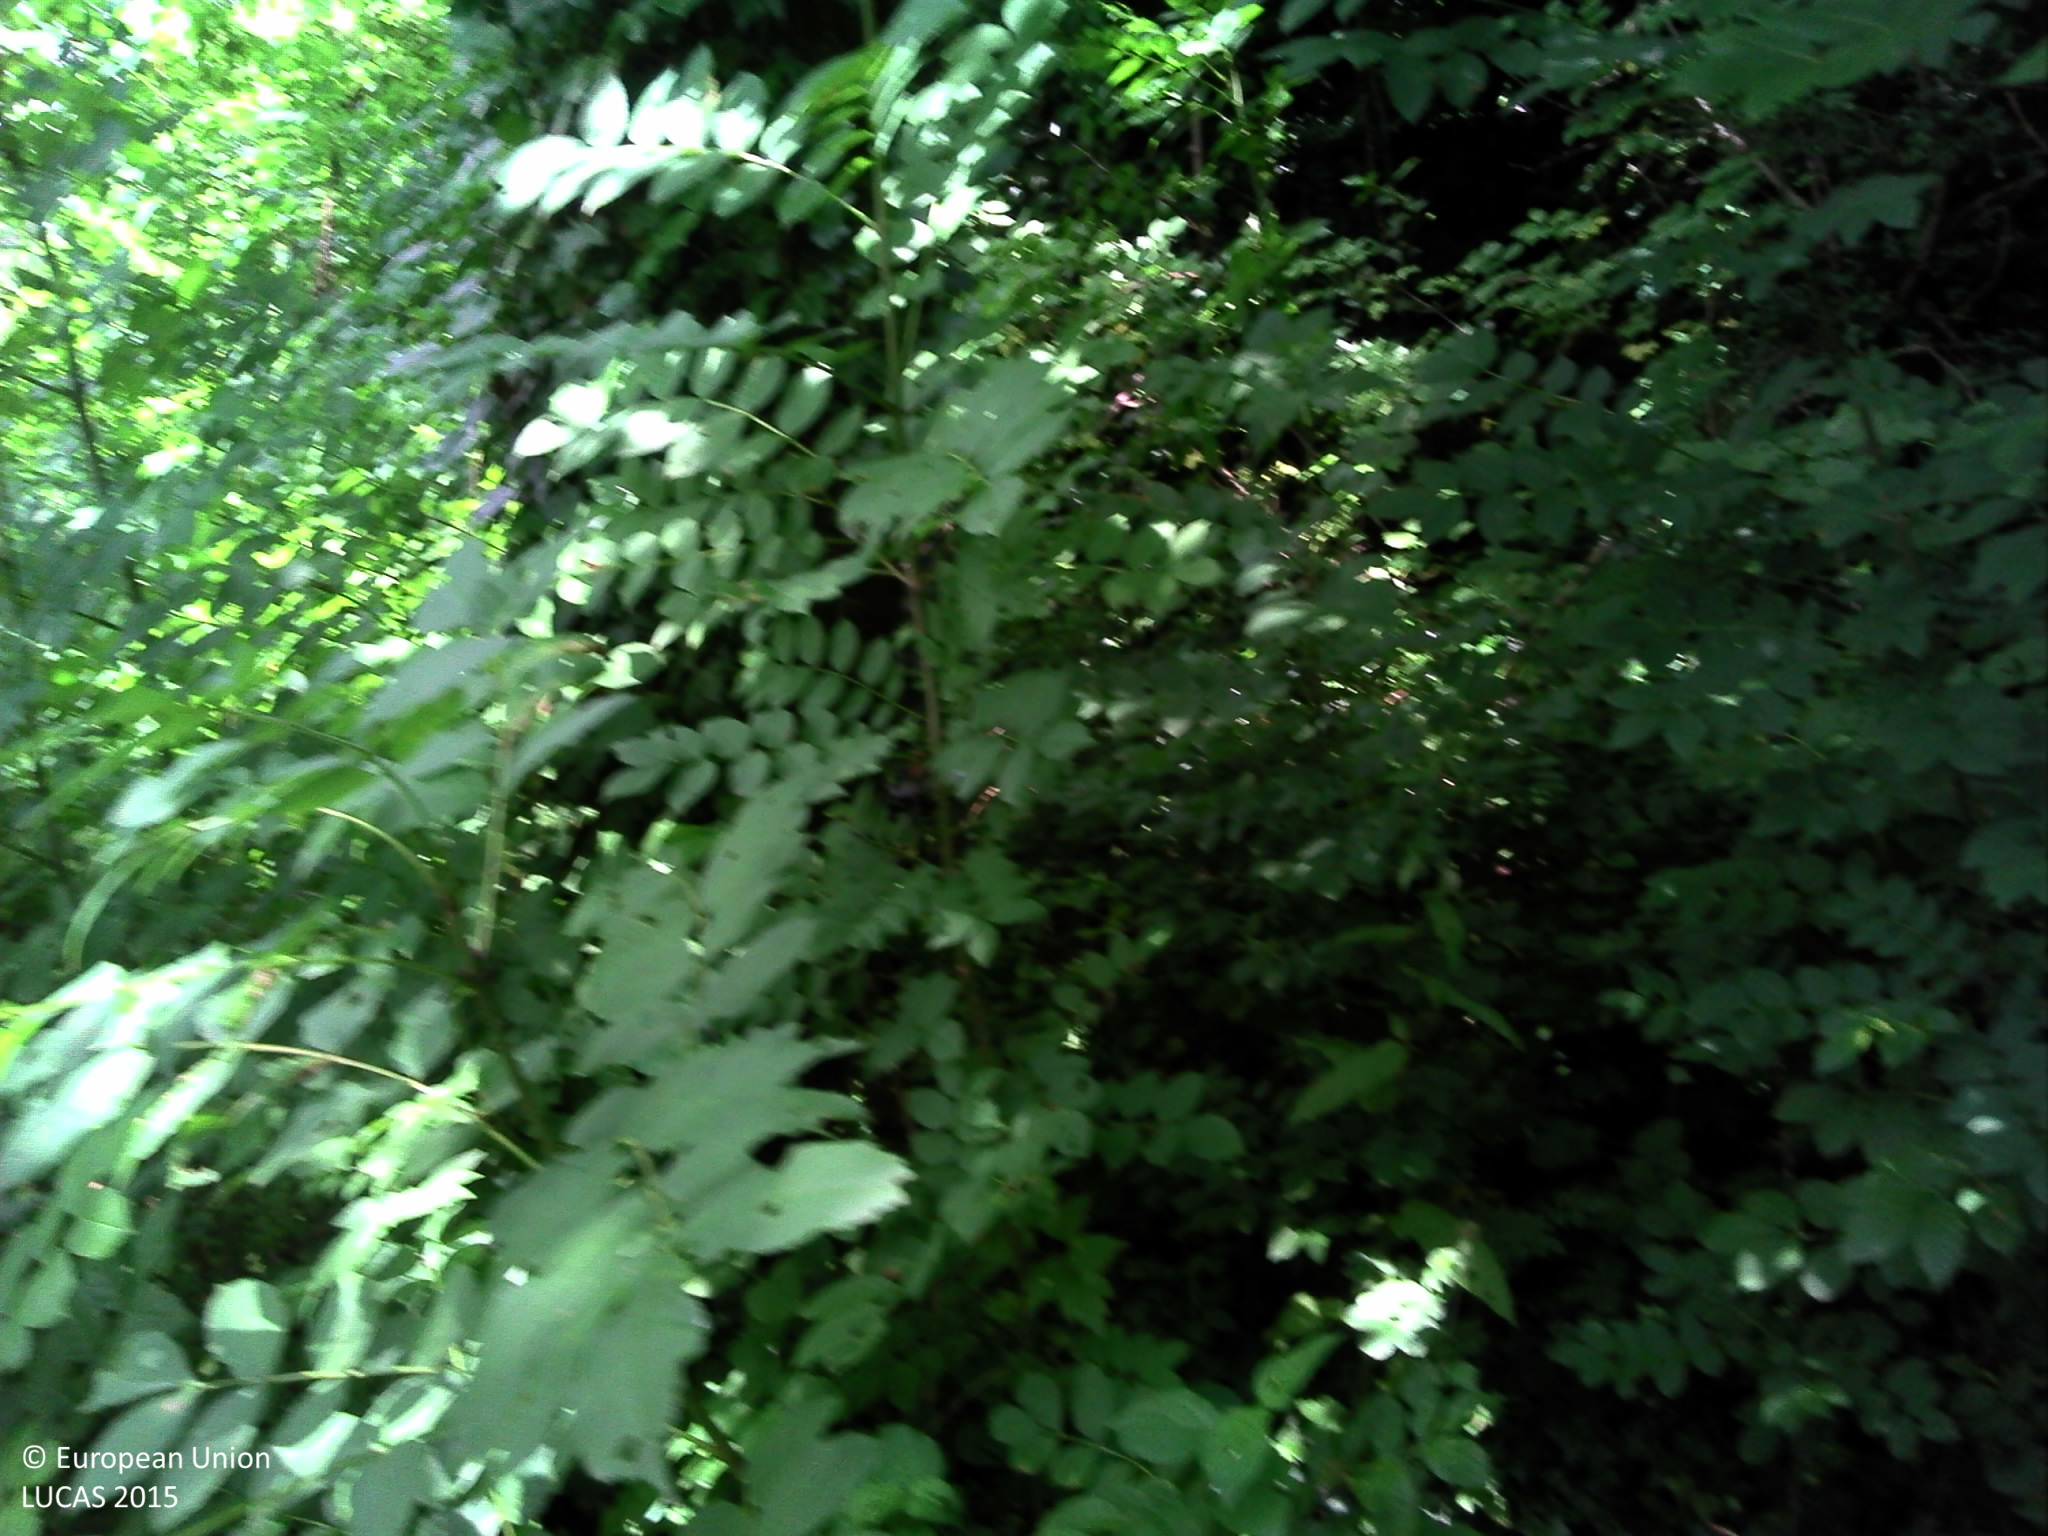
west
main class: Woodland
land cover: Broadleaved woodland
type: mesophytic deciduous forest
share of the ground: > 75 %
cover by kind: broadleaved forest trees 70 %, coniferous forest trees 10 %, shrubs 10 %, herbaceous plants 10 %
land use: Semi-natural and natural areas not in use
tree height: > 5 m
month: June
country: FR
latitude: 44.7379
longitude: 5.0434
